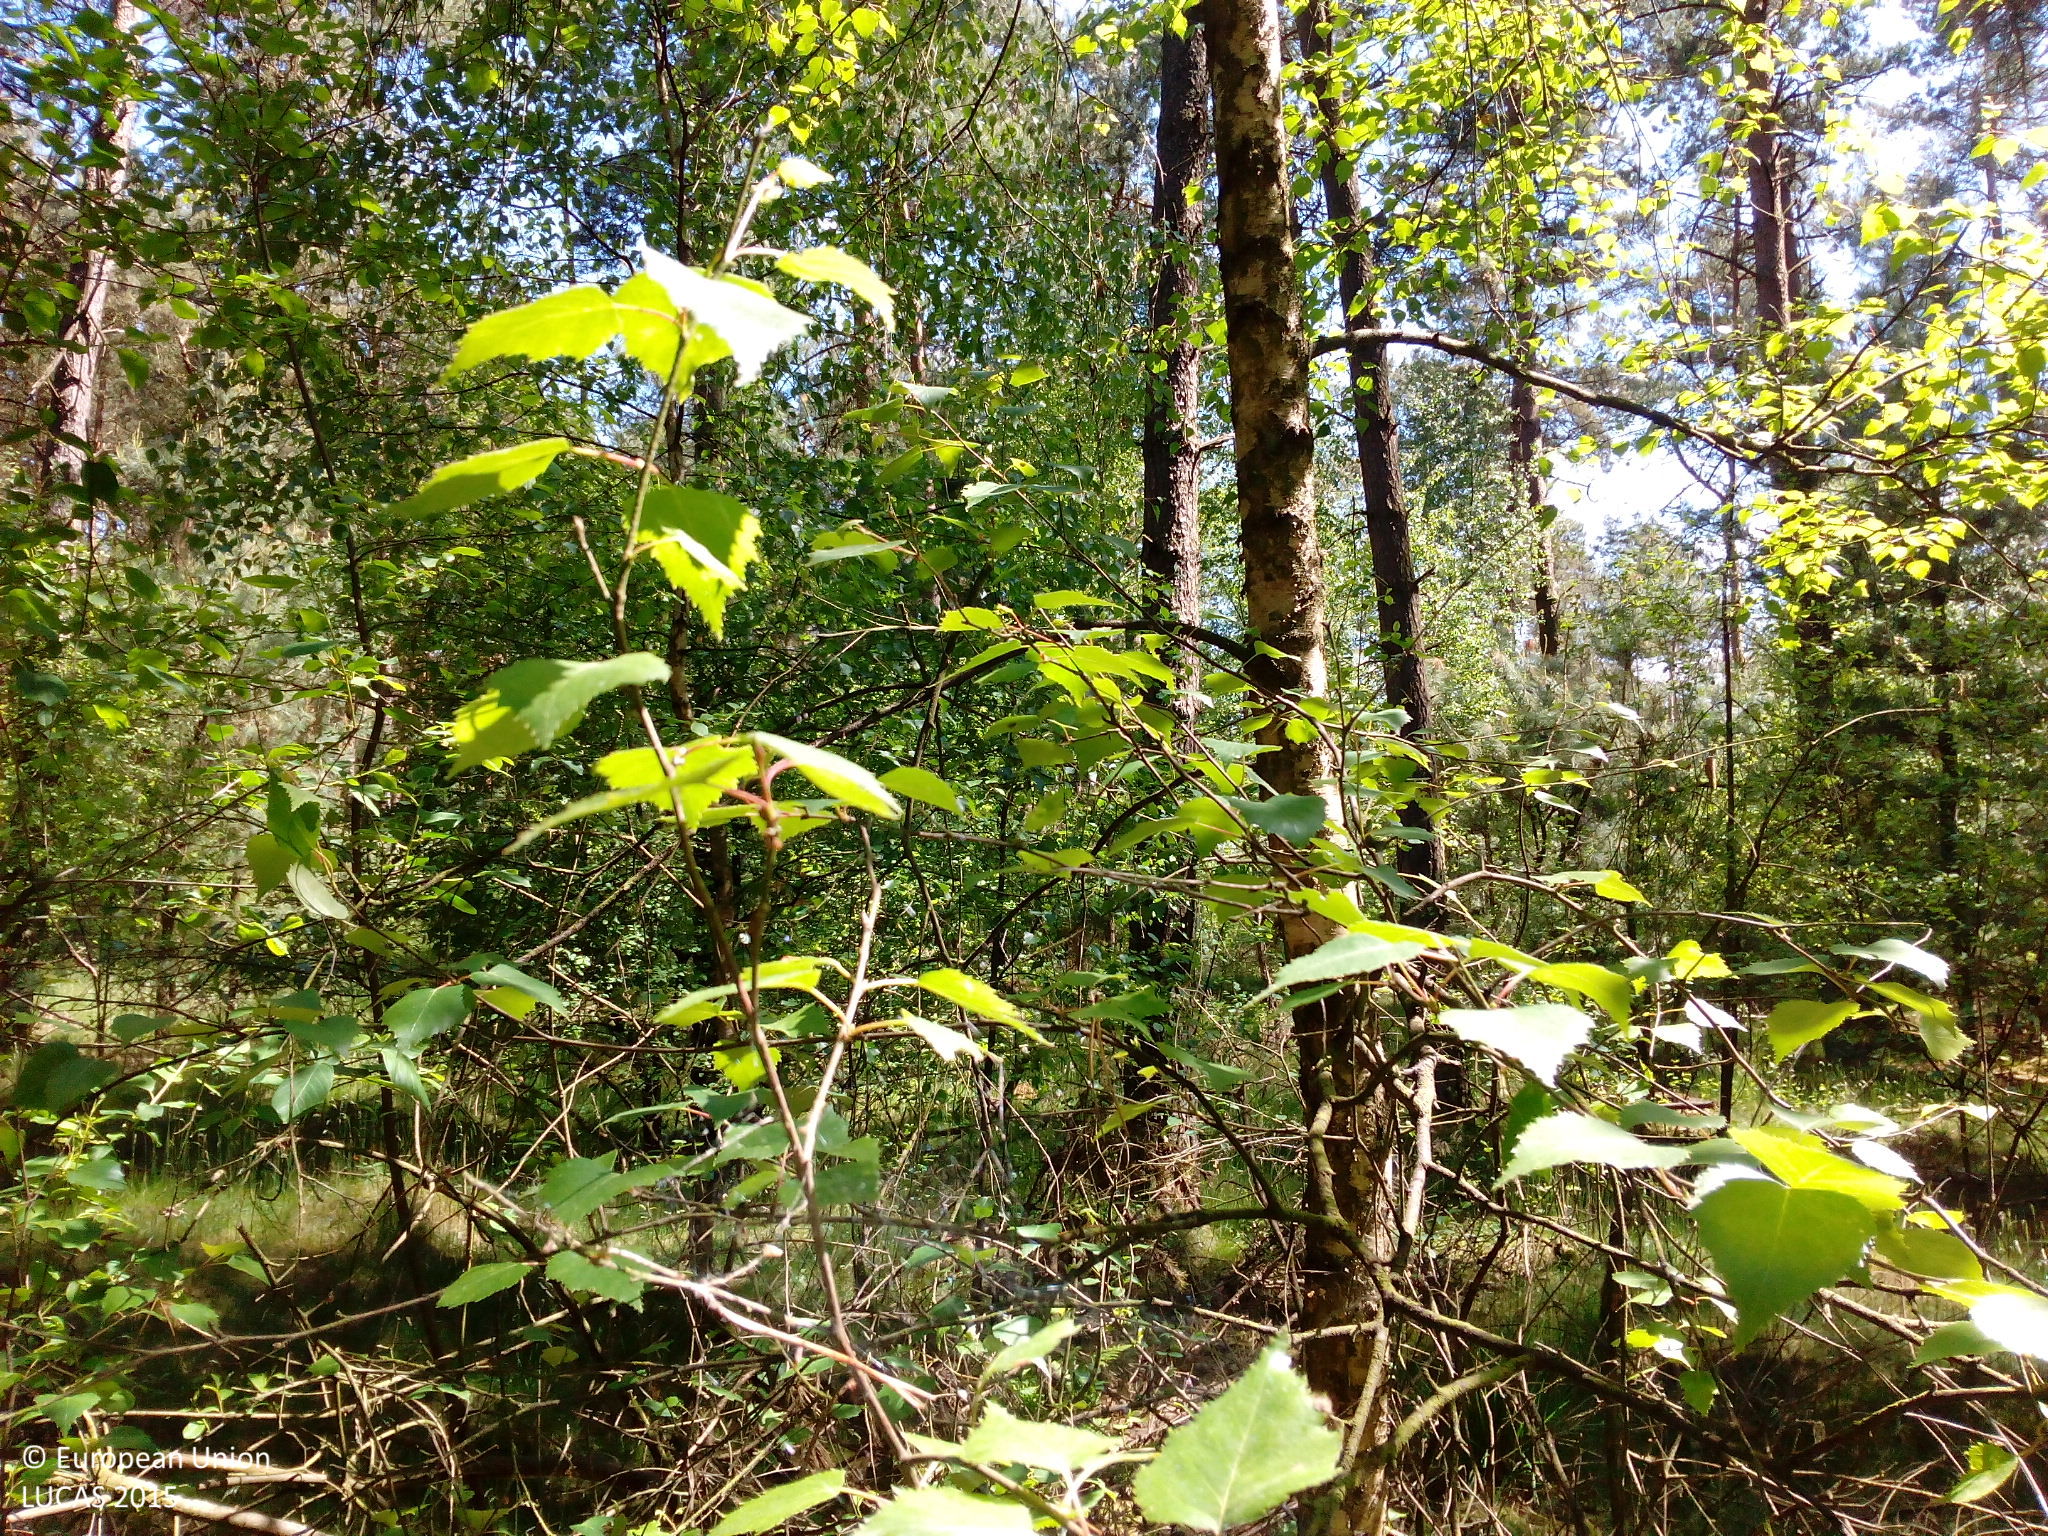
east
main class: Woodland
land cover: Pine dominated mixed woodland
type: hemiboreal forest and nemoral coniferous forest and mixed broadleaved-coniferous forest
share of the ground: > 75 %
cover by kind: coniferous forest trees 45 %, broadleaved forest trees 45 %, shrubs 5 %, herbaceous plants 5 %
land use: Forestry
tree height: > 5 m
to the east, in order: Pine dominated mixed woodland; Other mixed woodland; Grassland without tree/shrub cover; Paved roads, cycling and walking lanes
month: June
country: DE
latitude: 52.4023
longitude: 7.3694
